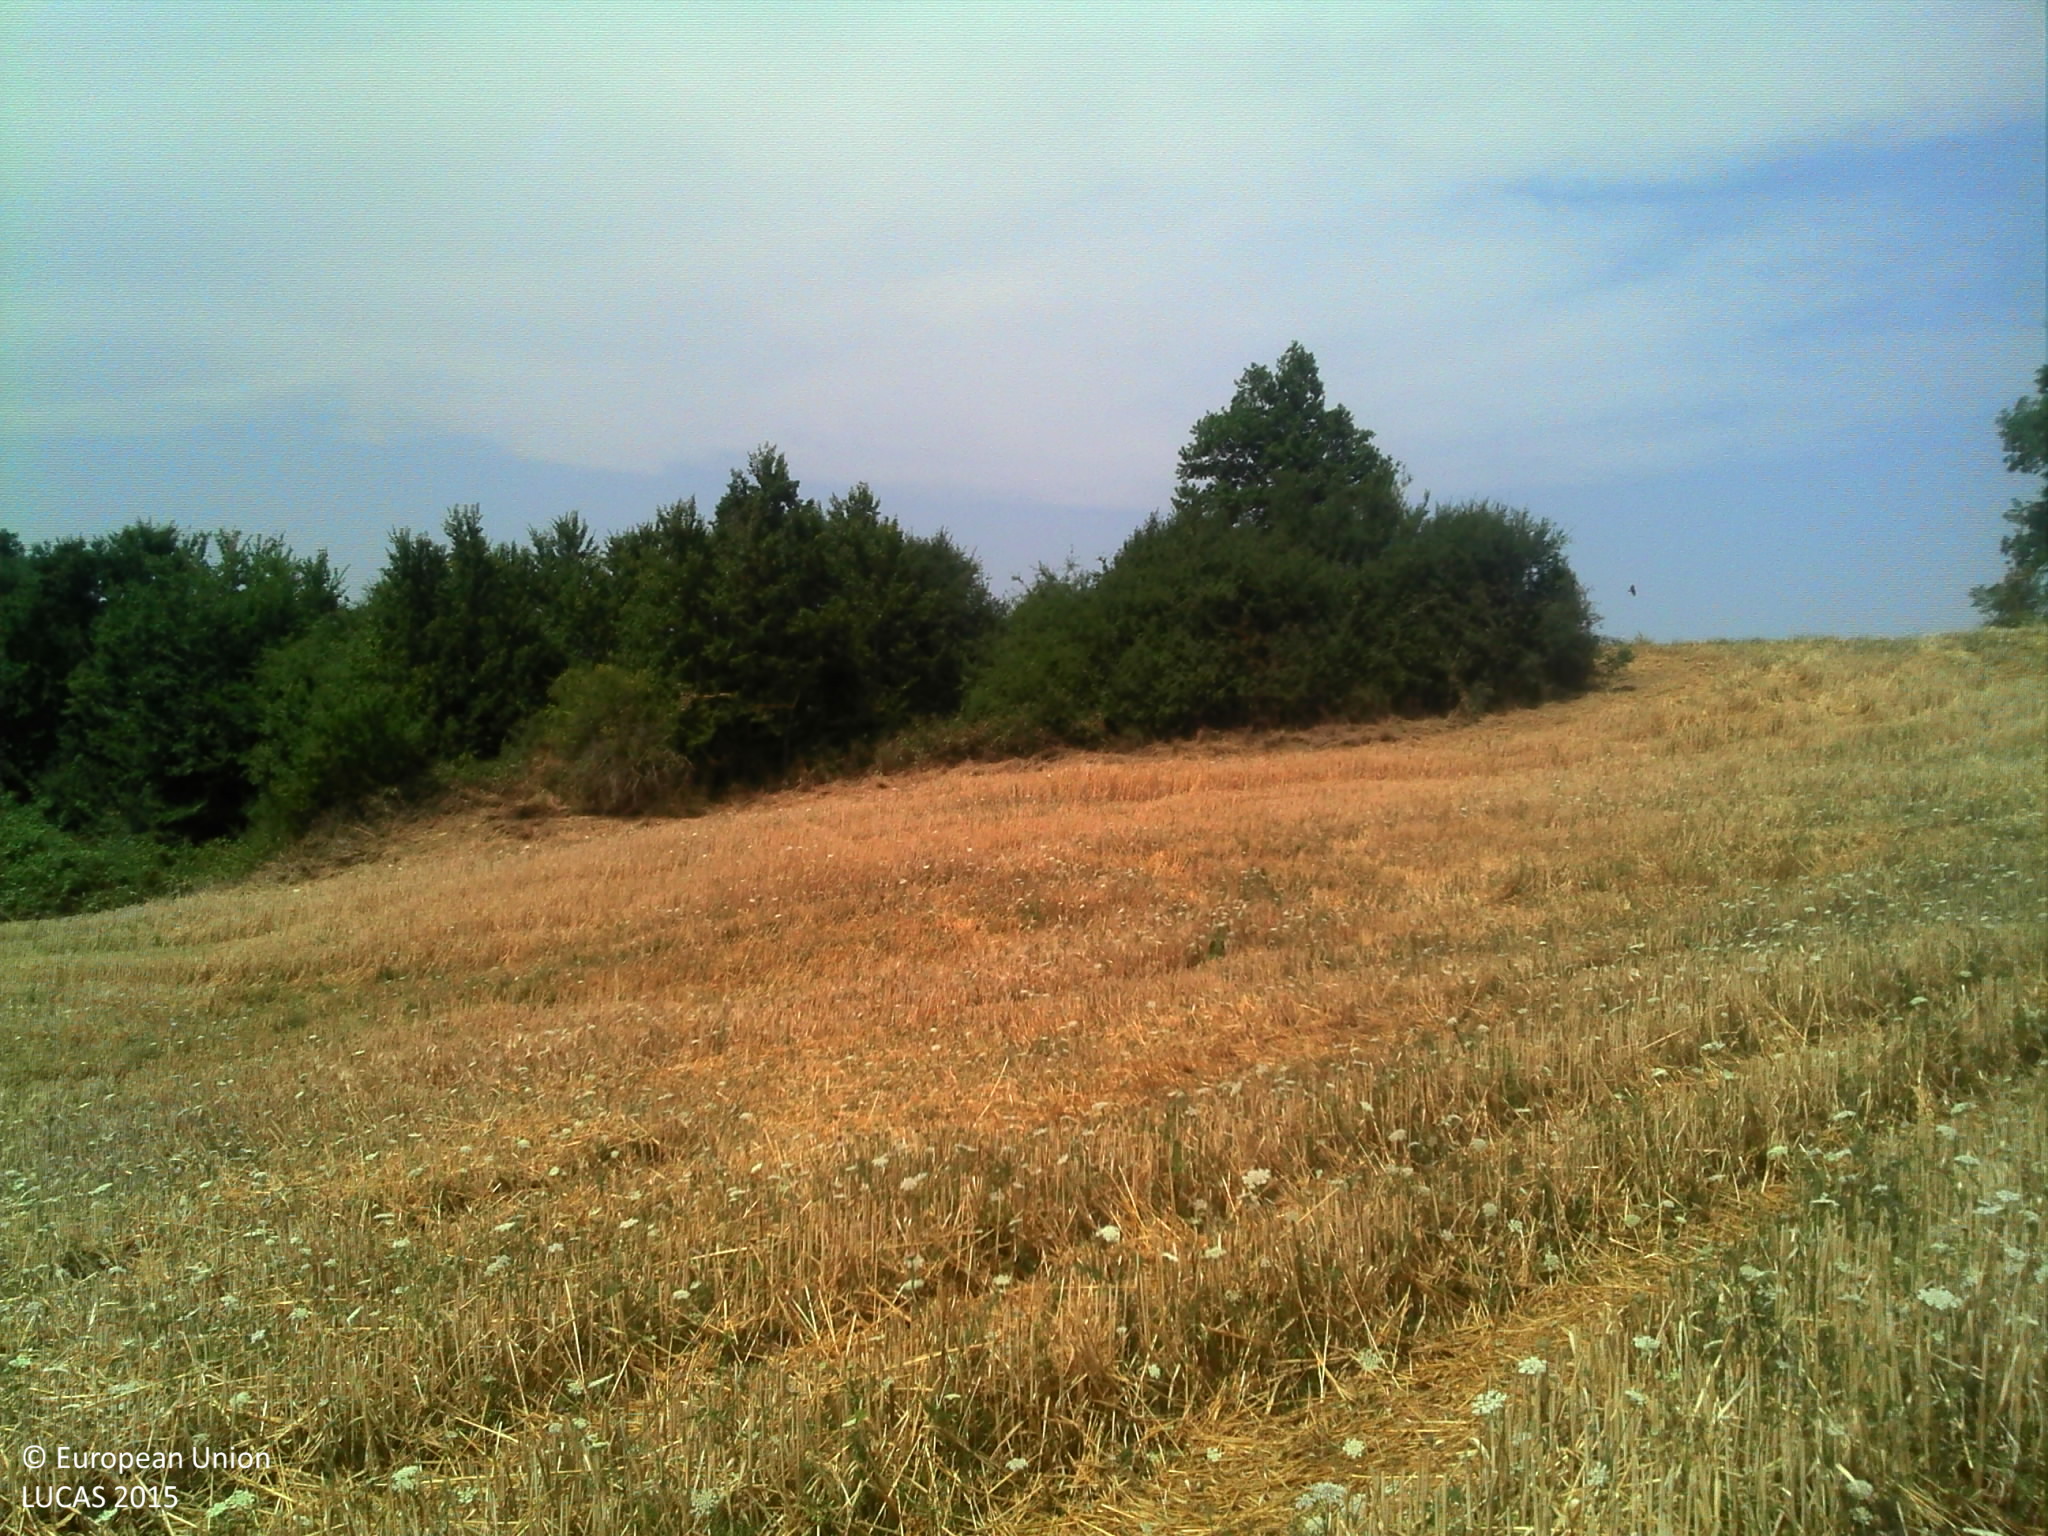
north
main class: Cropland
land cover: Barley
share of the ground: > 75 %
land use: Agriculture (excluding fallow land and kitchen gardens)
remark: Harvested field
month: July
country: FR
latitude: 43.2912
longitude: 1.0421
